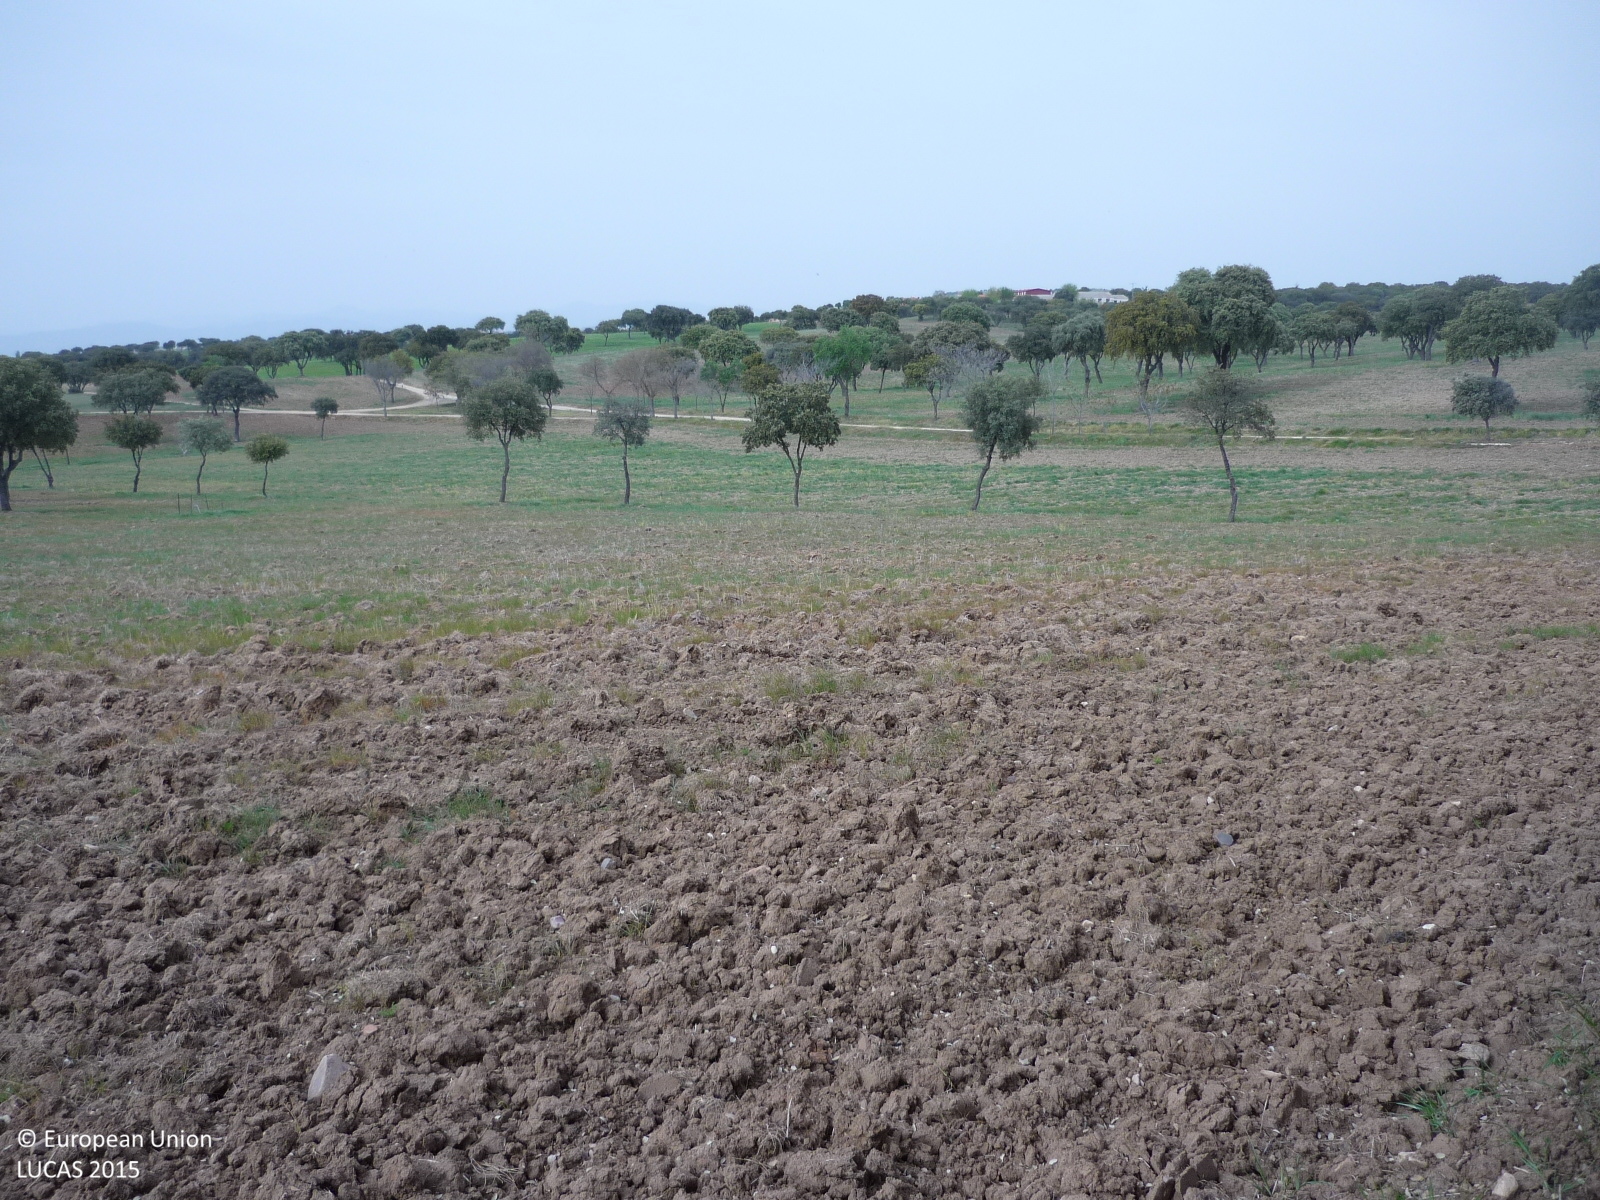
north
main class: Woodland
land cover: Pine dominated mixed woodland
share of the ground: > 75 %
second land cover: Spontaneously vegetated surfaces
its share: 25 - 50 %
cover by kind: coniferous forest trees 50 %, broadleaved forest trees 25 %, herbaceous plants 25 %
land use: Forestry
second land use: Agriculture (excluding fallow land and kitchen gardens)
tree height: > 5 m
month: April
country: ES
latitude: 40.6533
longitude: -3.4607
